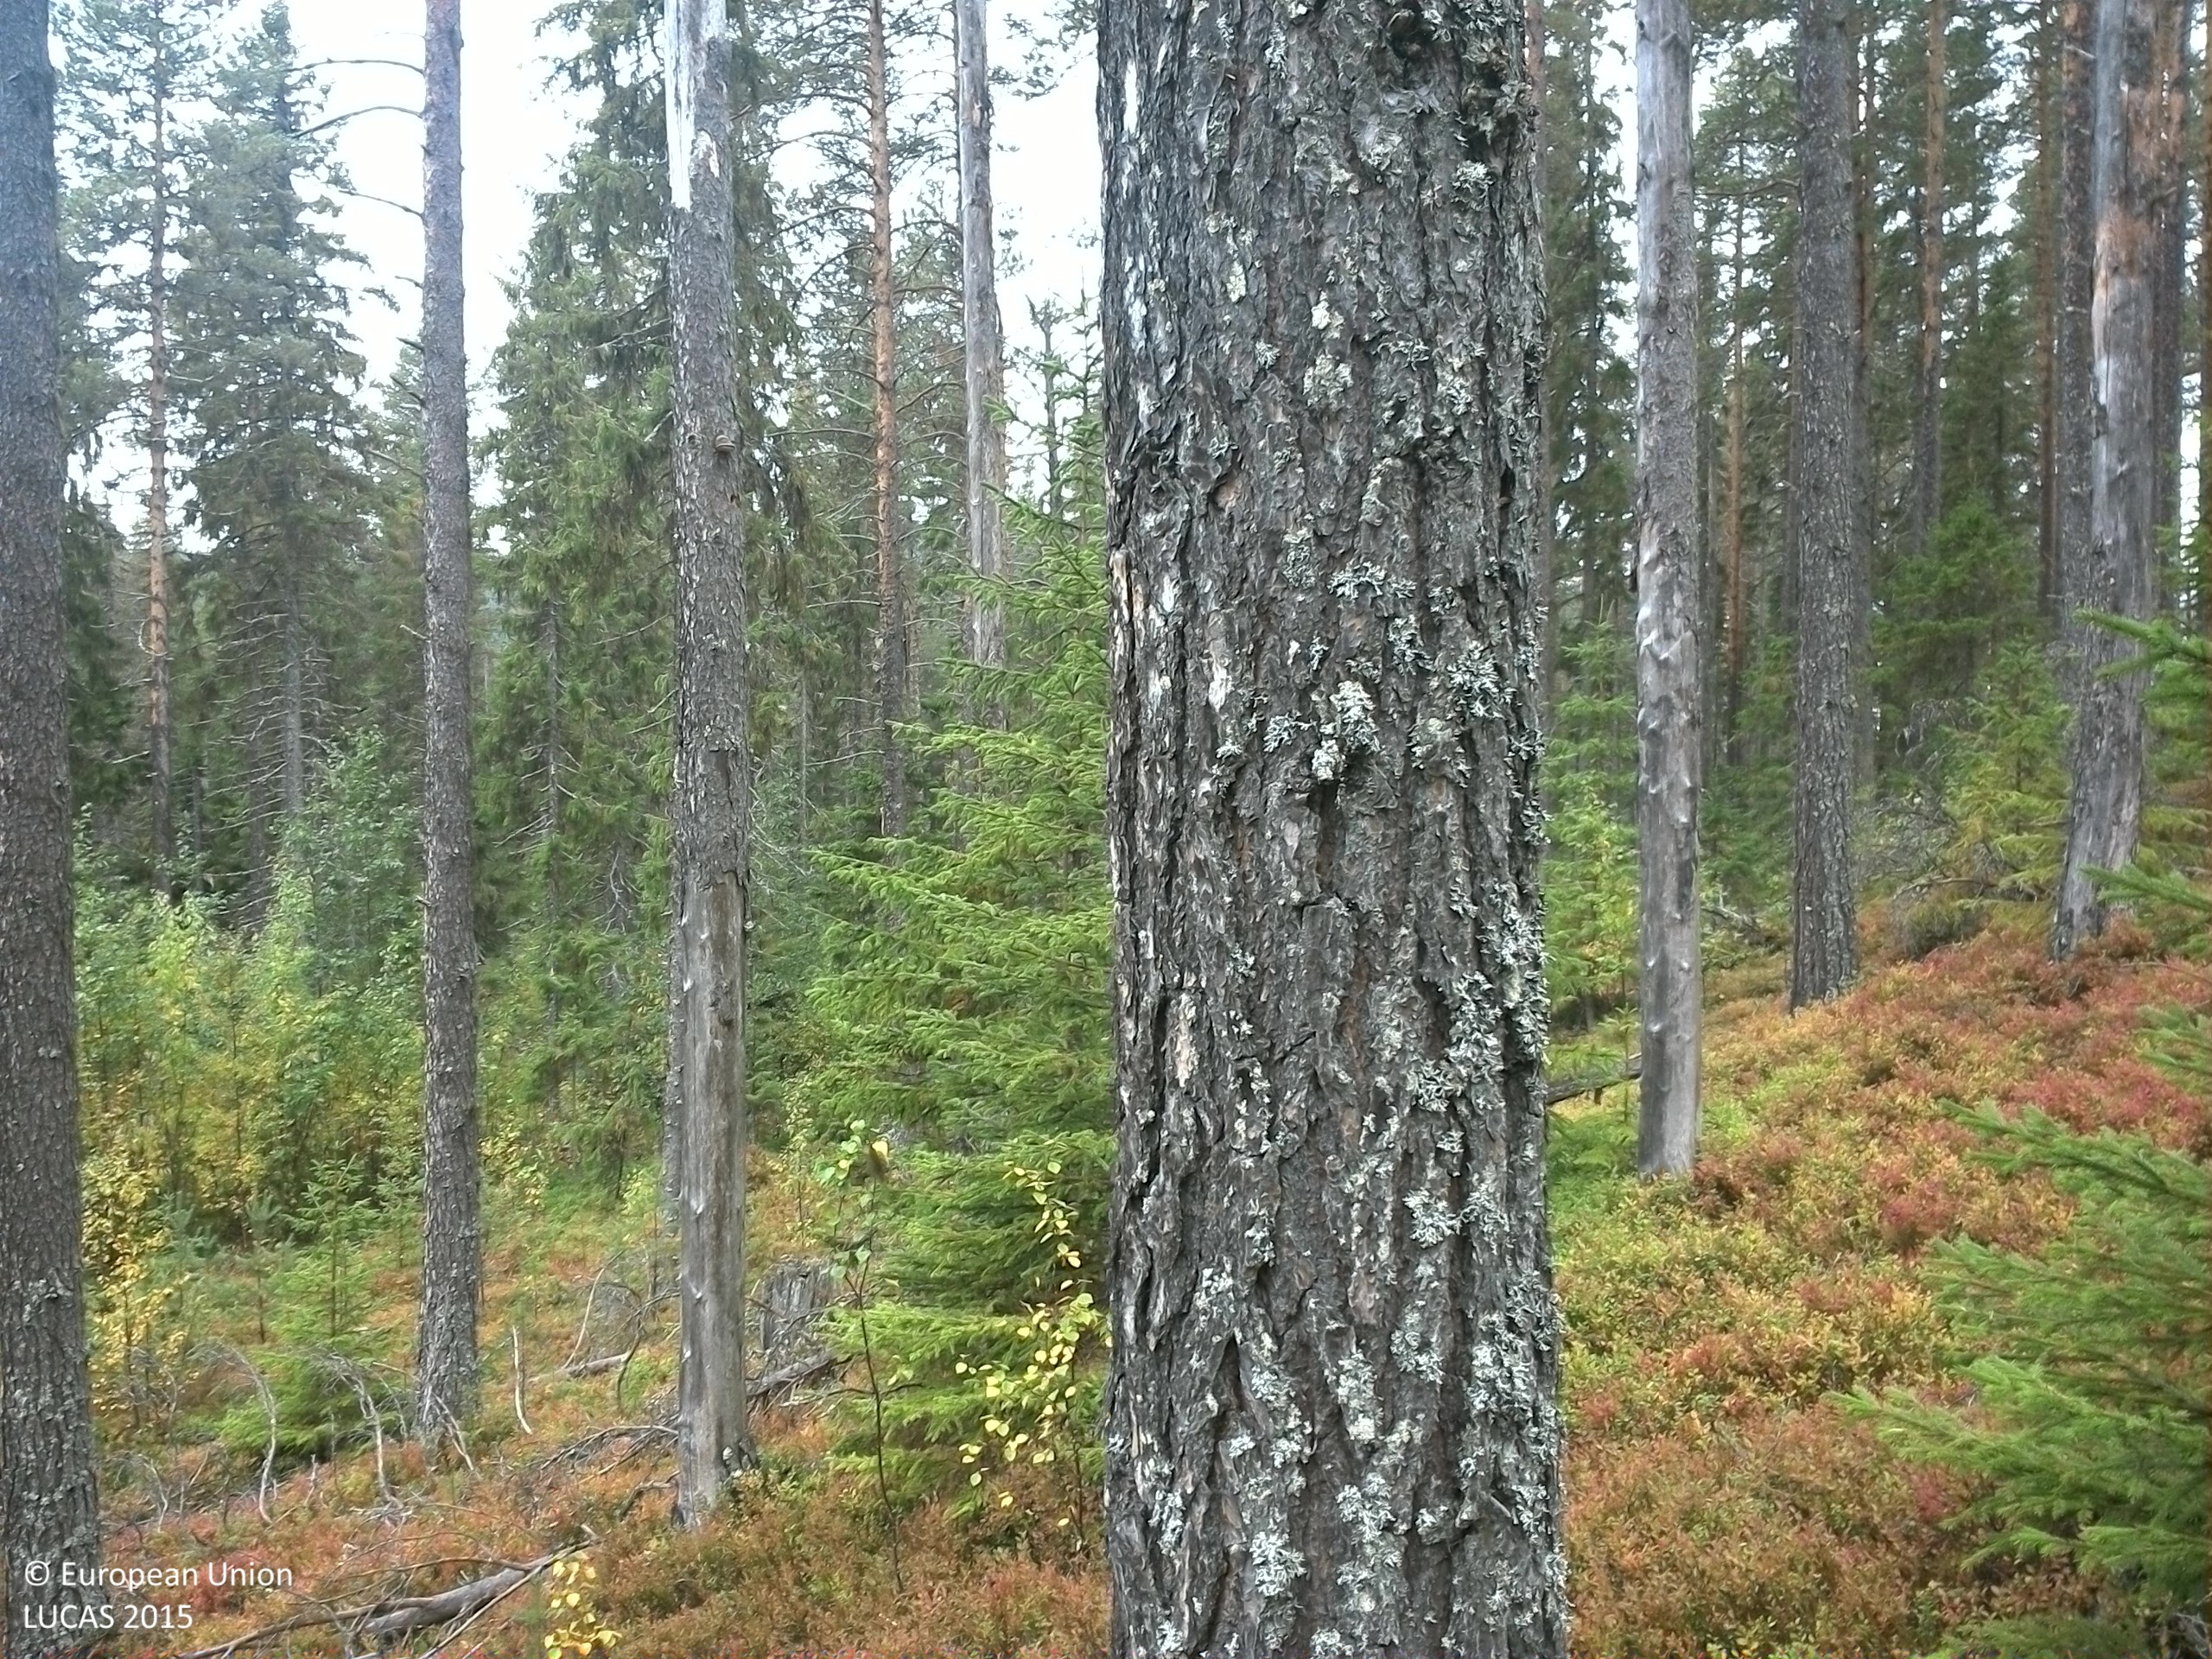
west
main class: Woodland
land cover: Pine dominated coniferous woodland
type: boreal forest
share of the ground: 50 - 75 %
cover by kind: coniferous forest trees 45 %, shrubs 35 %, broadleaved forest trees 10 %, lichens and mosses 10 %
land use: Forestry
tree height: > 5 m
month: September
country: SE
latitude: 63.6785
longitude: 16.2192
